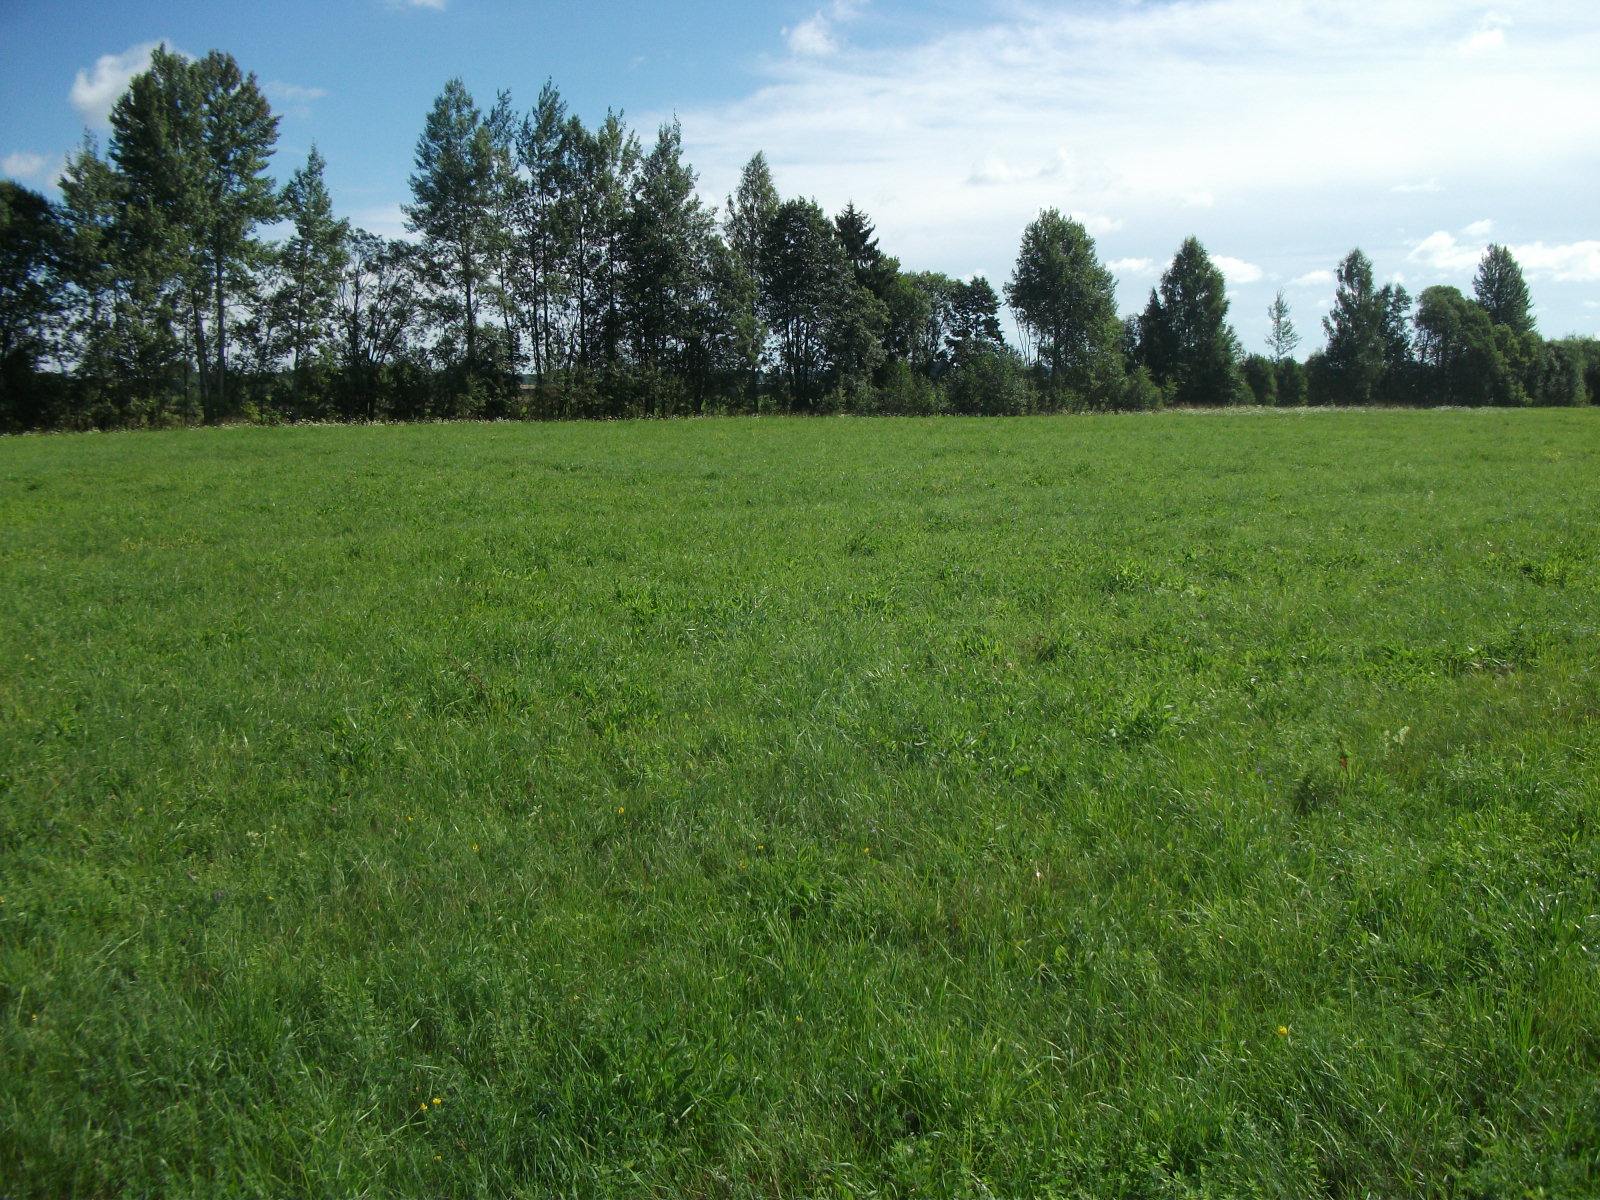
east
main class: Grassland
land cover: Grassland without tree/shrub cover
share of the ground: > 75 %
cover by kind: herbaceous plants 100 %
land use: Agriculture (excluding fallow land and kitchen gardens)
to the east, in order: Grassland without tree/shrub cover; Broadleaved woodland; Ditches and canals; Abandoned hedges; Grassland without tree/shrub cover
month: August
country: LV
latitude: 56.4443
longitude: 26.4158
